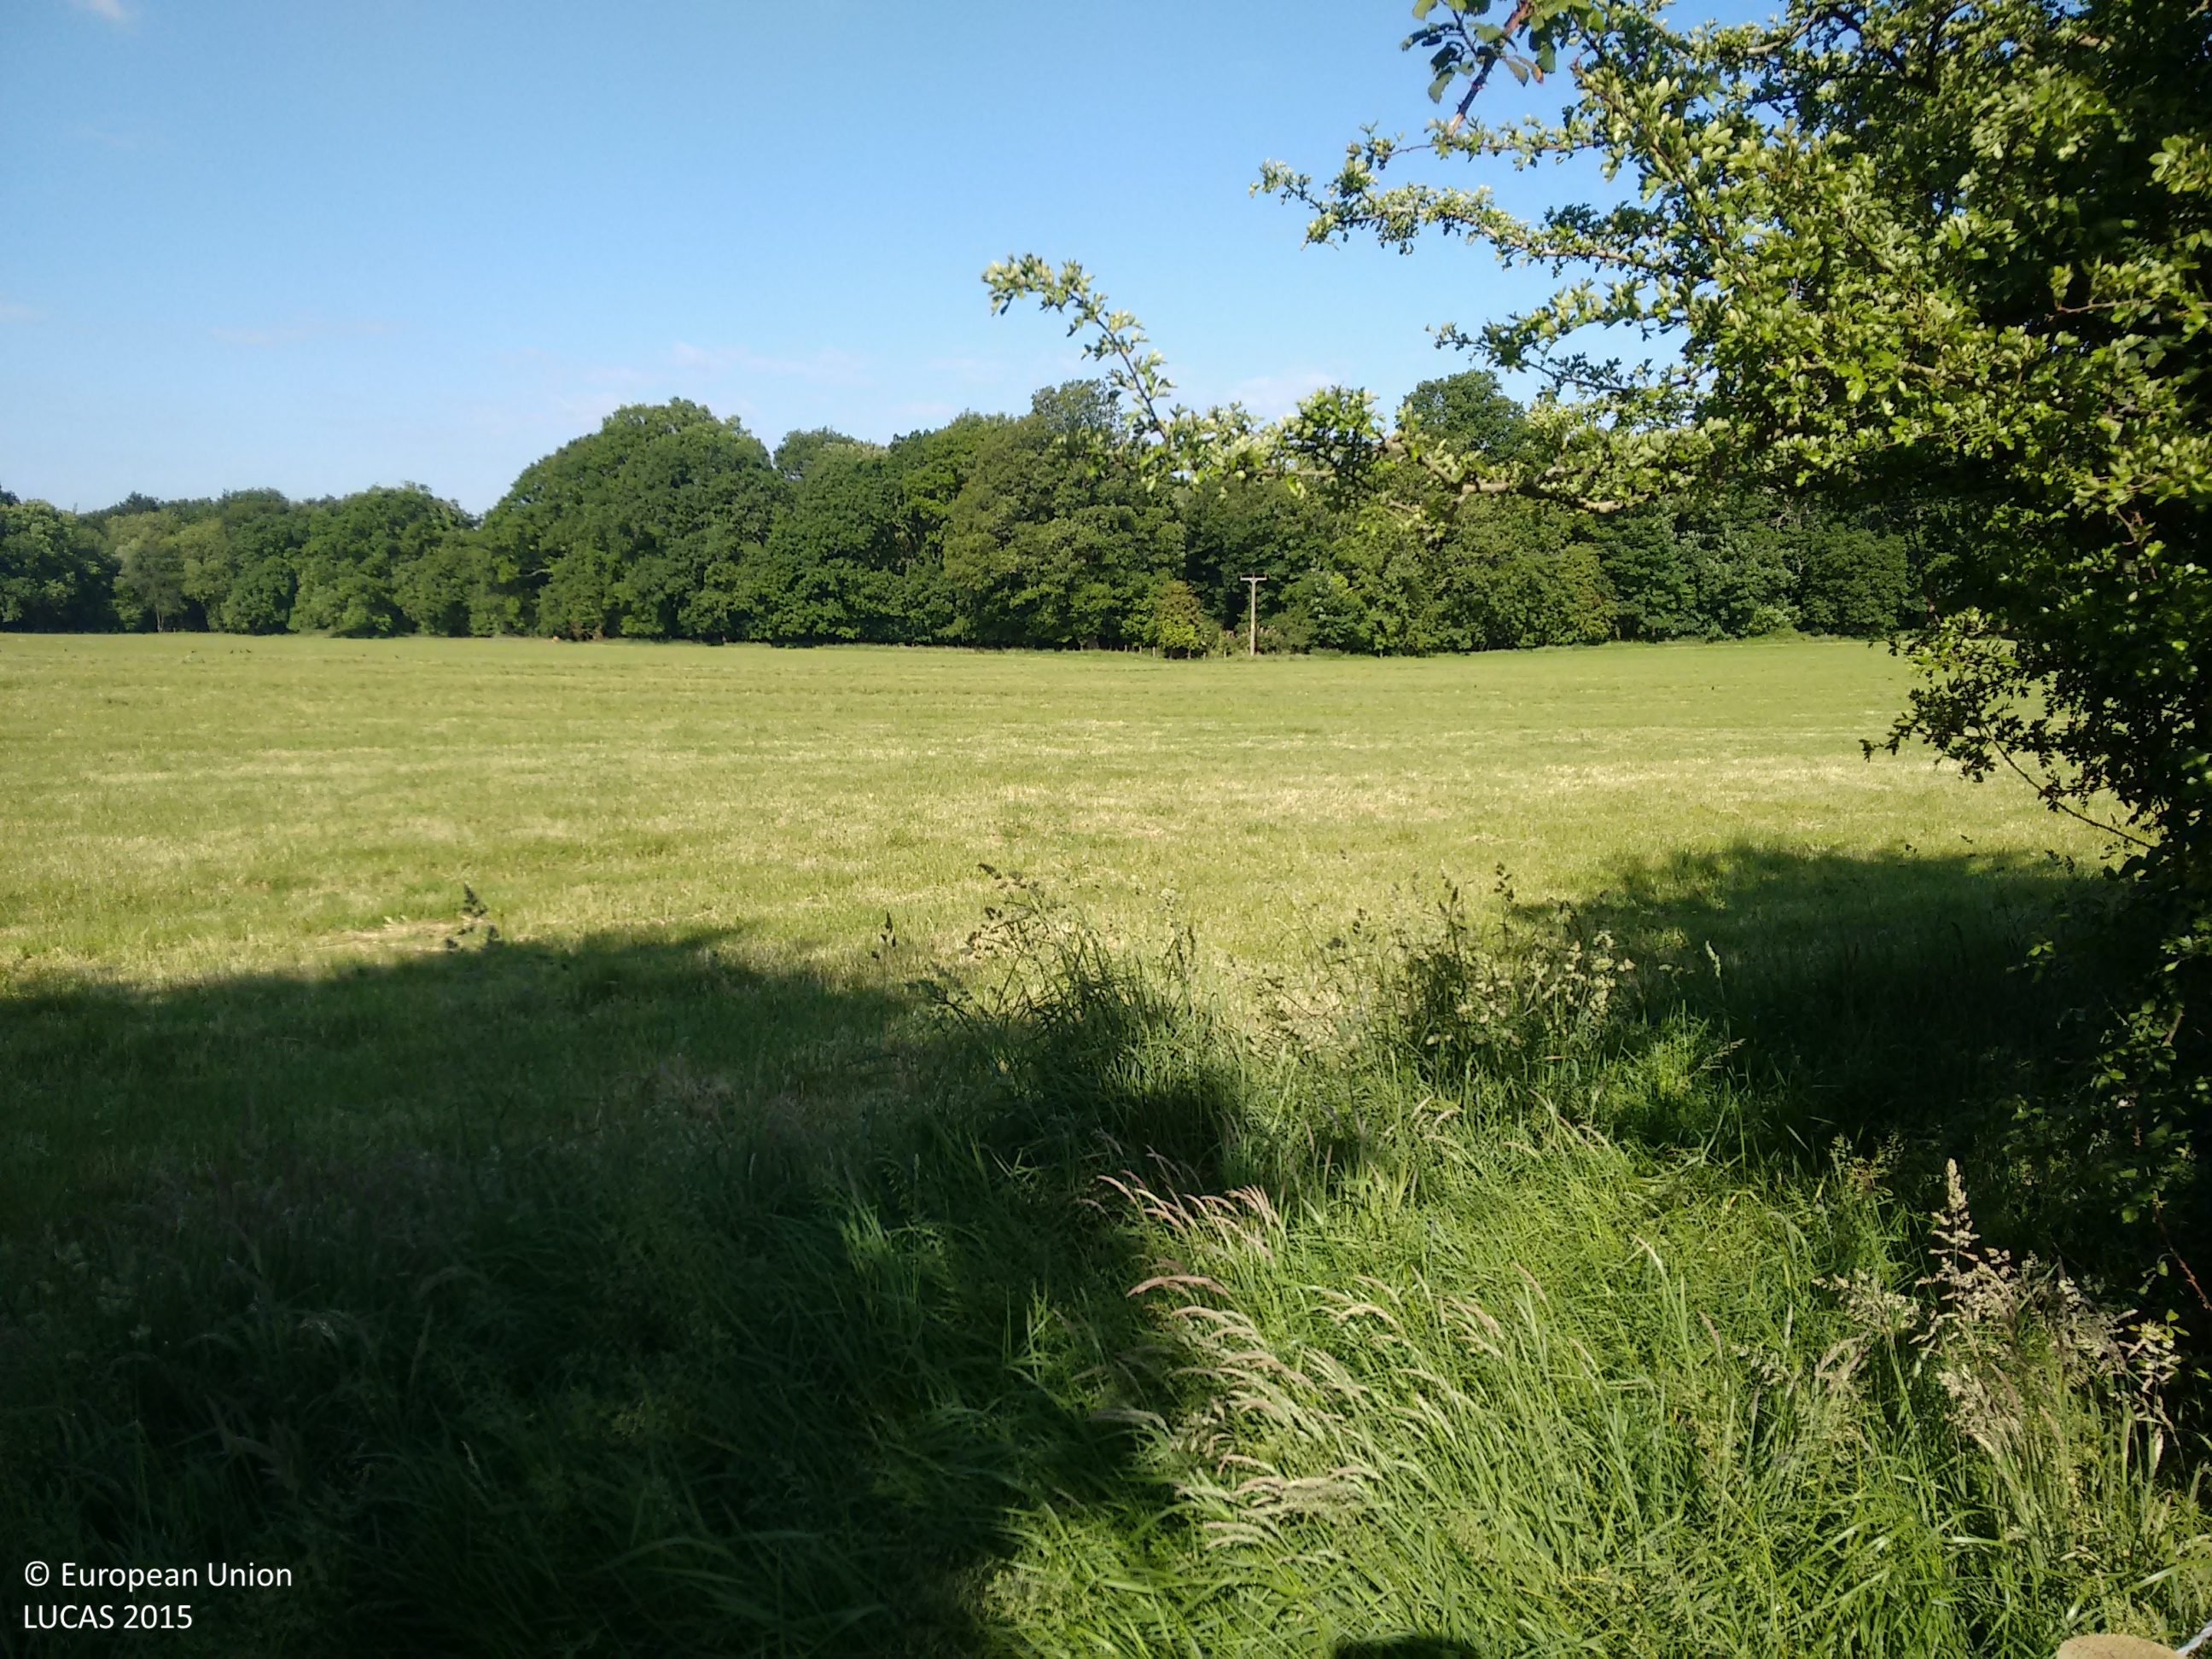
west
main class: Grassland
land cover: Grassland without tree/shrub cover
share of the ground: > 75 %
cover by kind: herbaceous plants 100 %
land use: Agriculture (excluding fallow land and kitchen gardens)
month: June
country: GB
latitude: 50.9875
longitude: -1.4326
